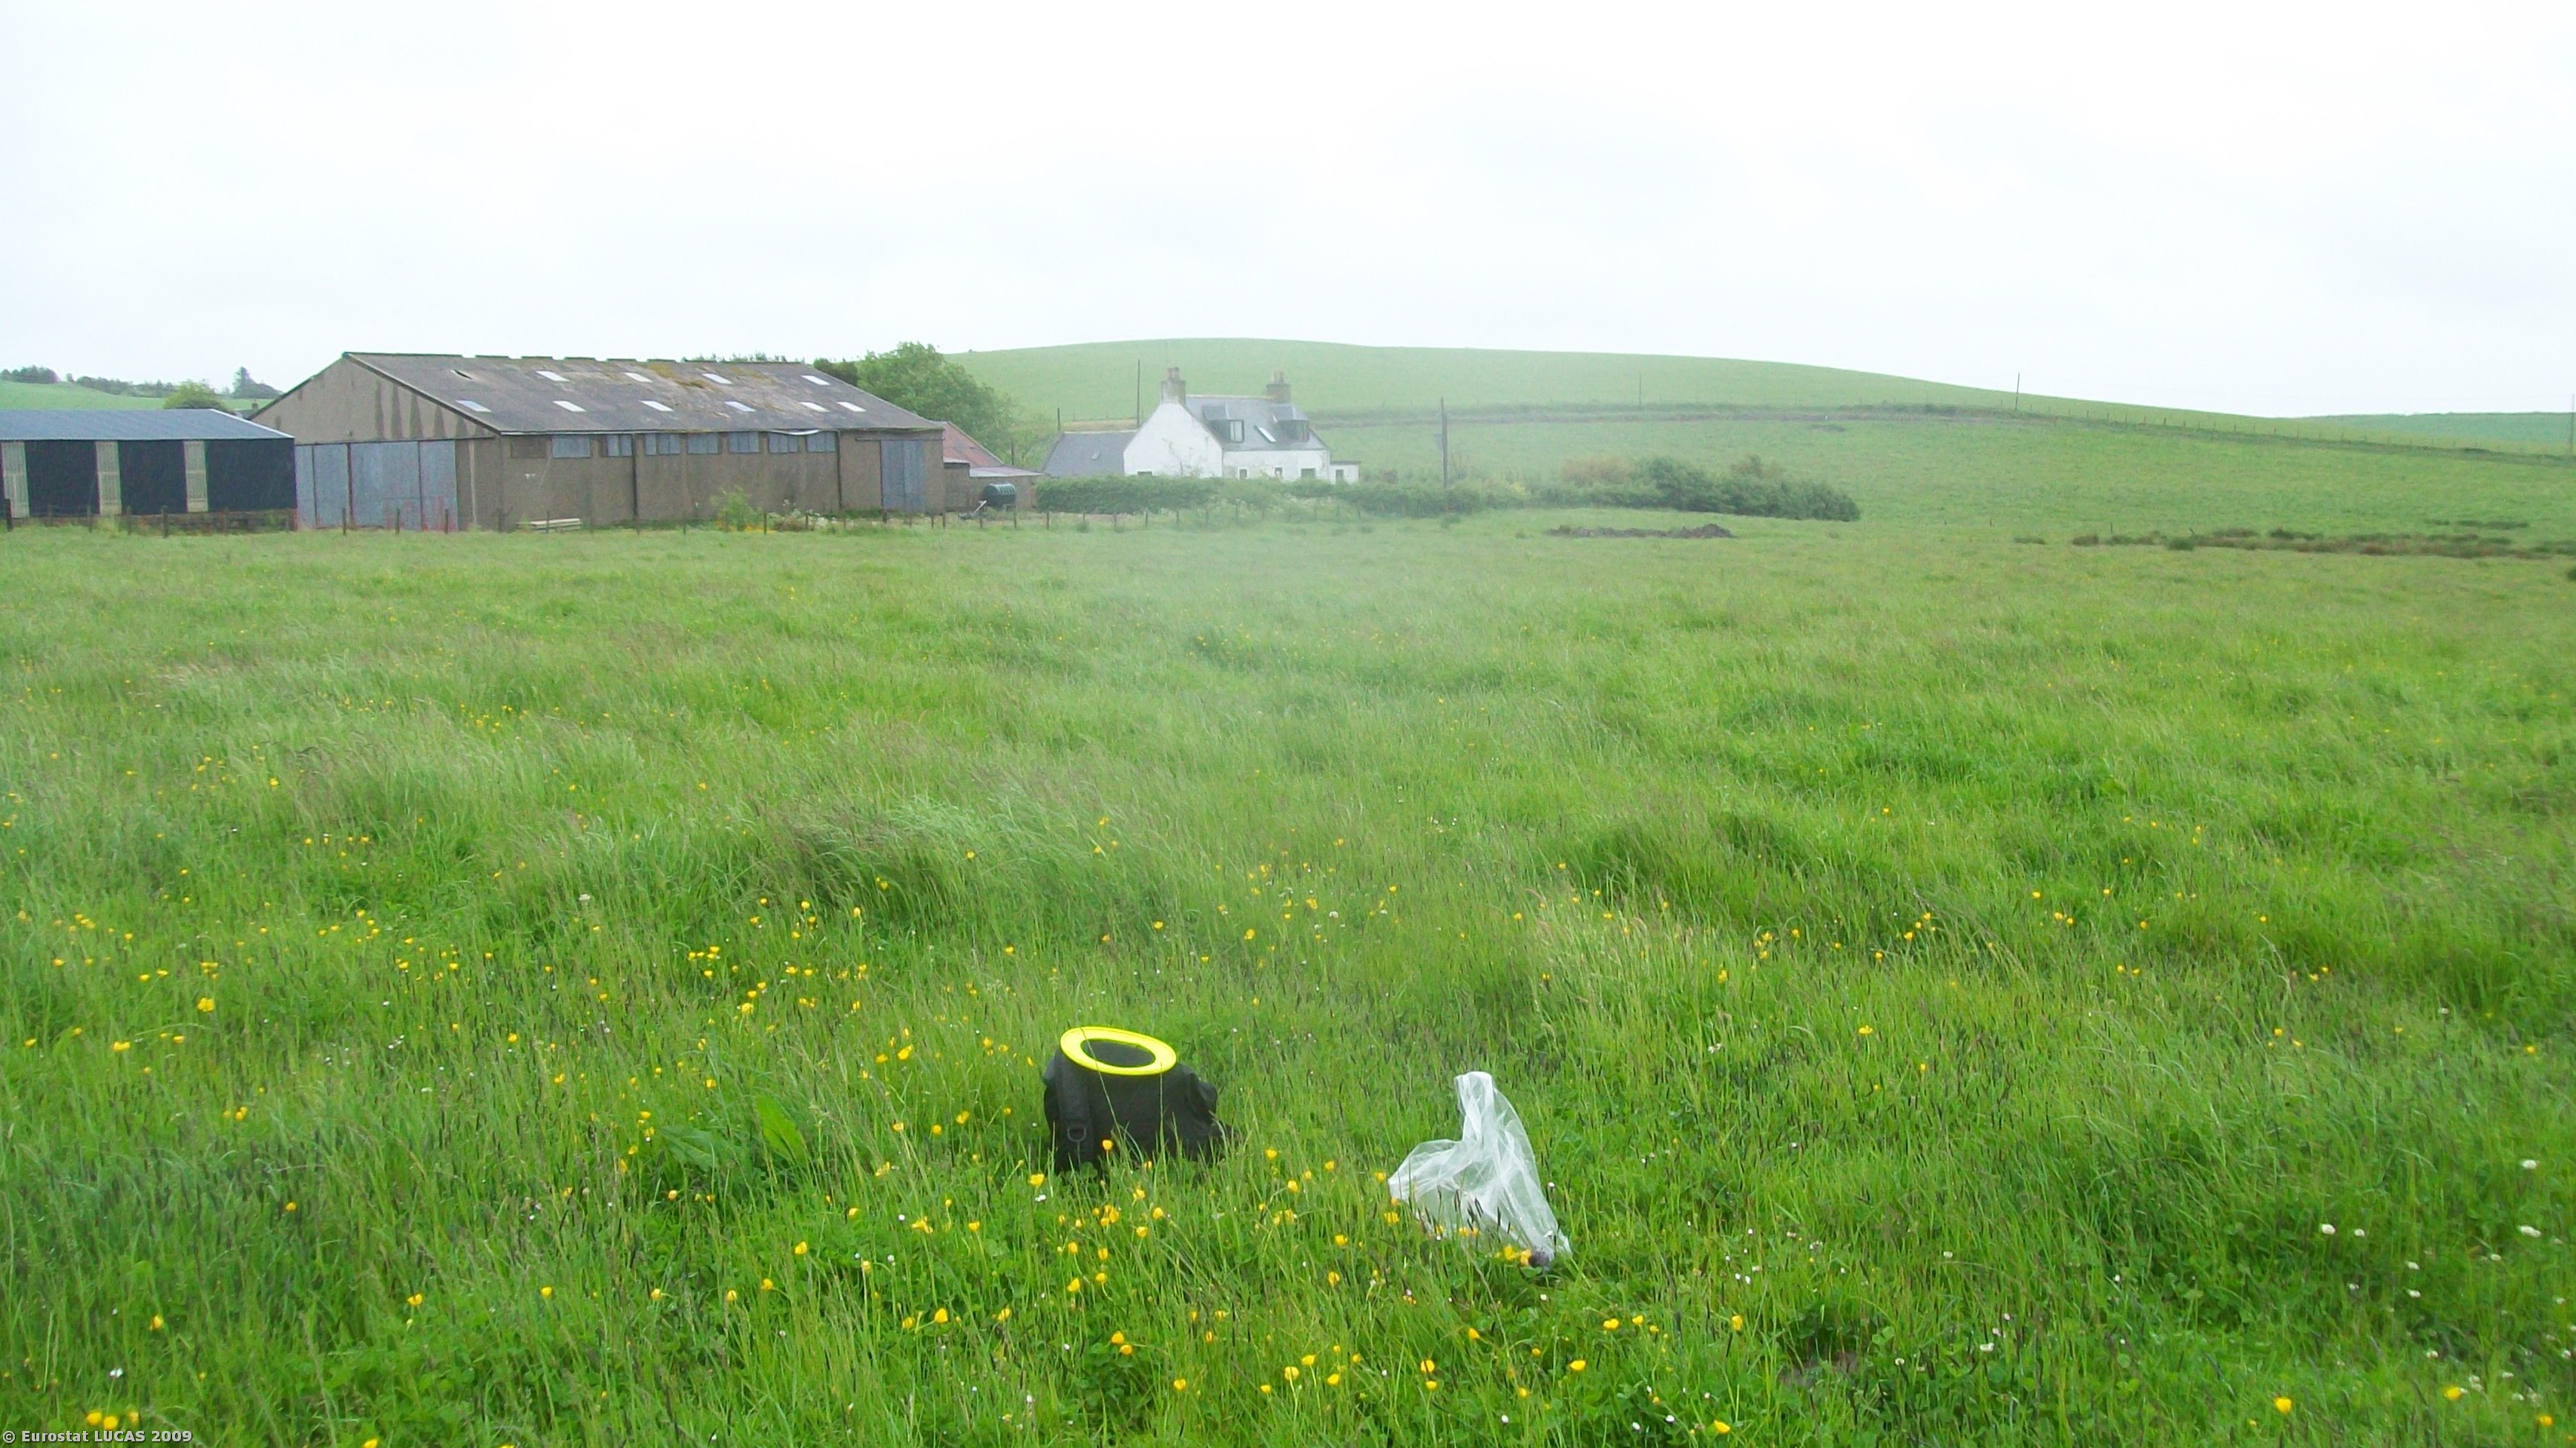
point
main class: Grassland
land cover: Grassland without tree/shrub cover
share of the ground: > 75 %
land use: Agriculture (excluding fallow land and kitchen gardens)
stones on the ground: 10 - 25 %
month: June
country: GB
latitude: 57.5887
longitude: -2.5828
